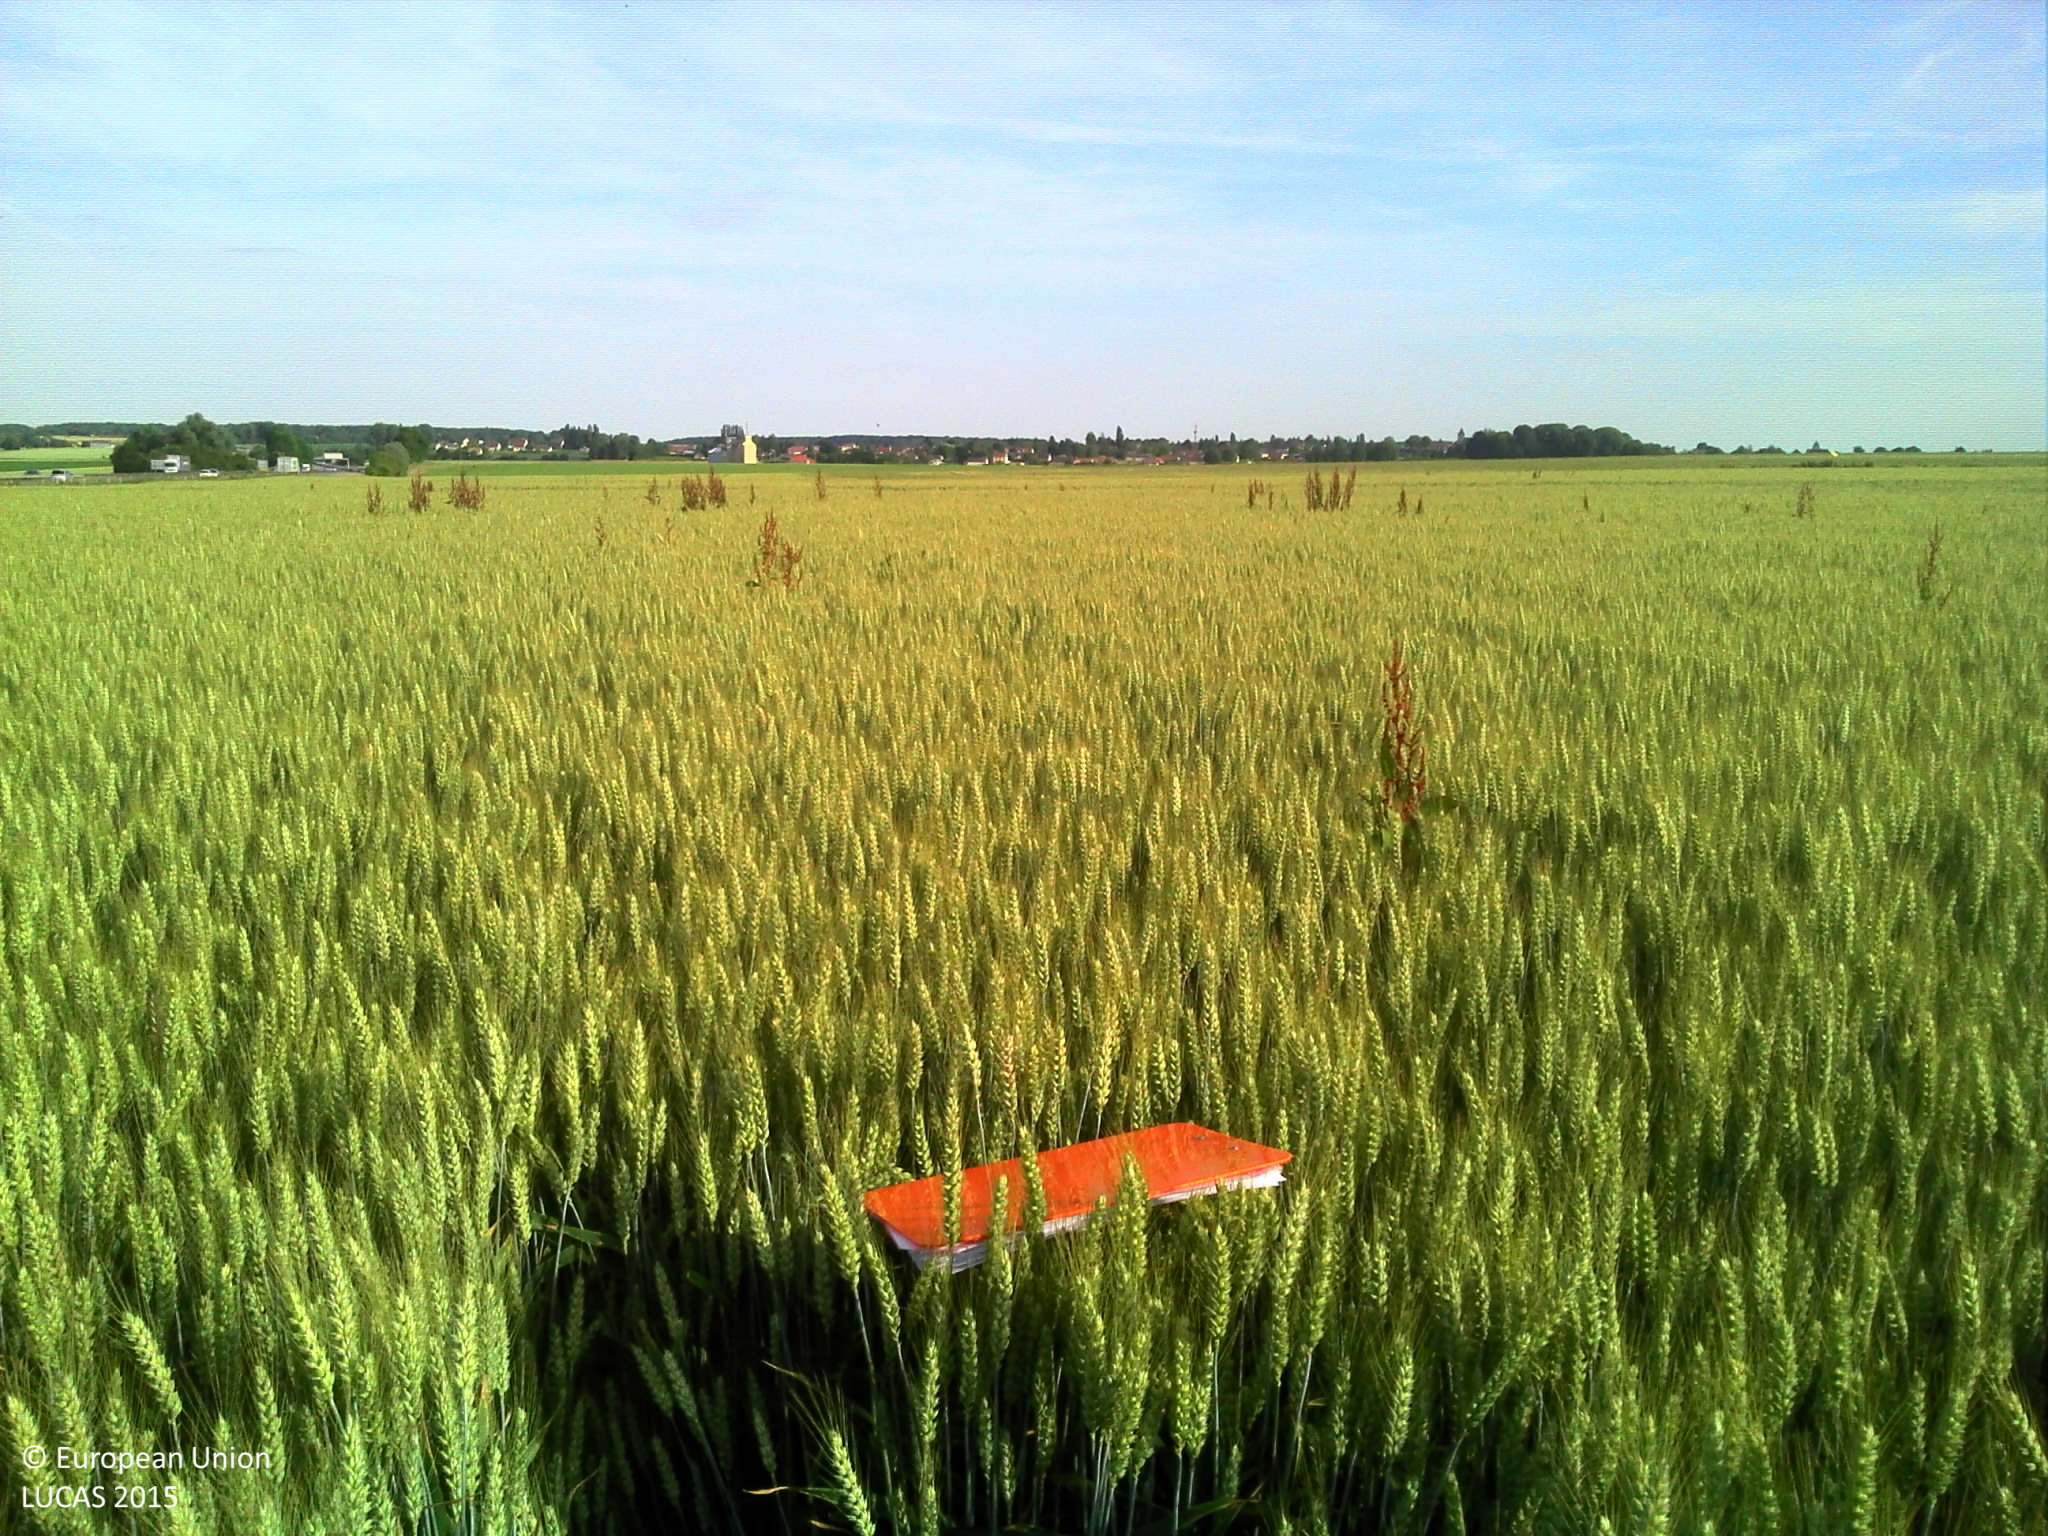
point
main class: Cropland
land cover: Common wheat
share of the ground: > 75 %
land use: Agriculture (excluding fallow land and kitchen gardens)
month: June
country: FR
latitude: 49.1773
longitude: 1.2418
